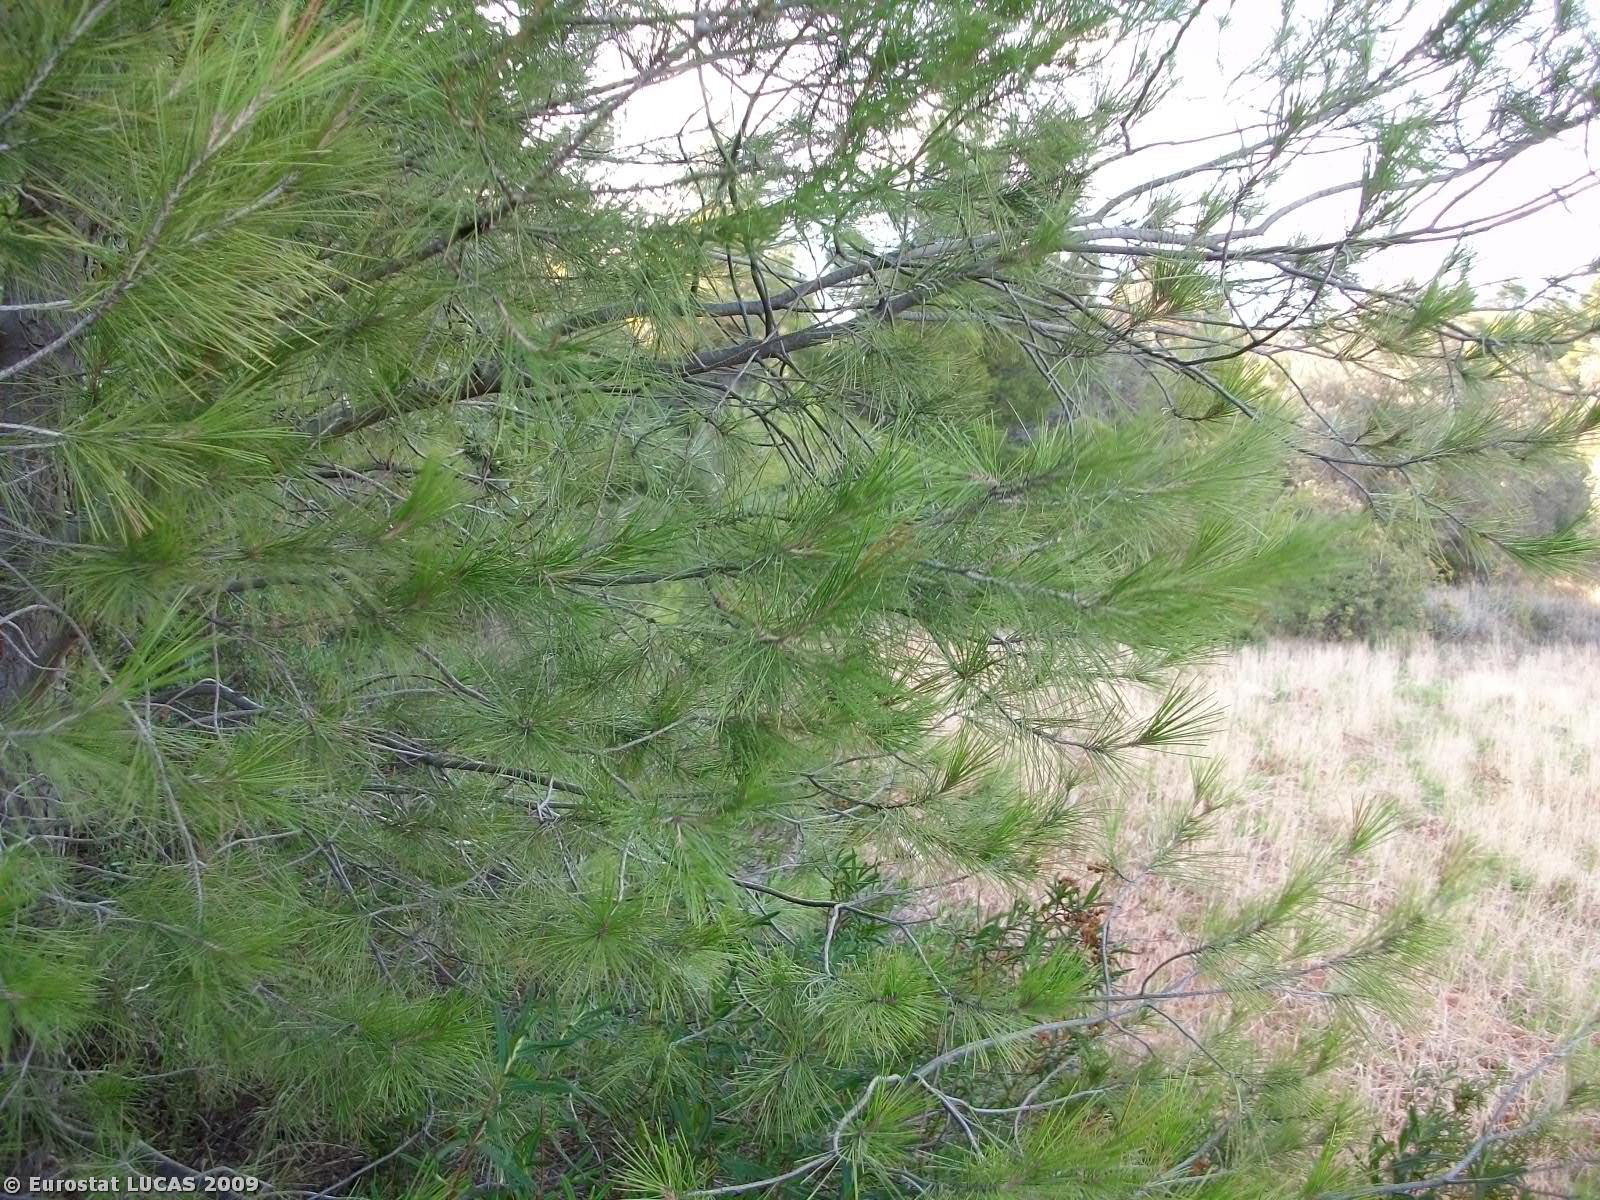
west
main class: Woodland
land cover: Mixed woodland
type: coniferous forest of the mediterranean region
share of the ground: > 75 %
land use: Forestry
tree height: > 5 m
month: September
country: GR
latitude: 38.2301
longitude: 24.0043
